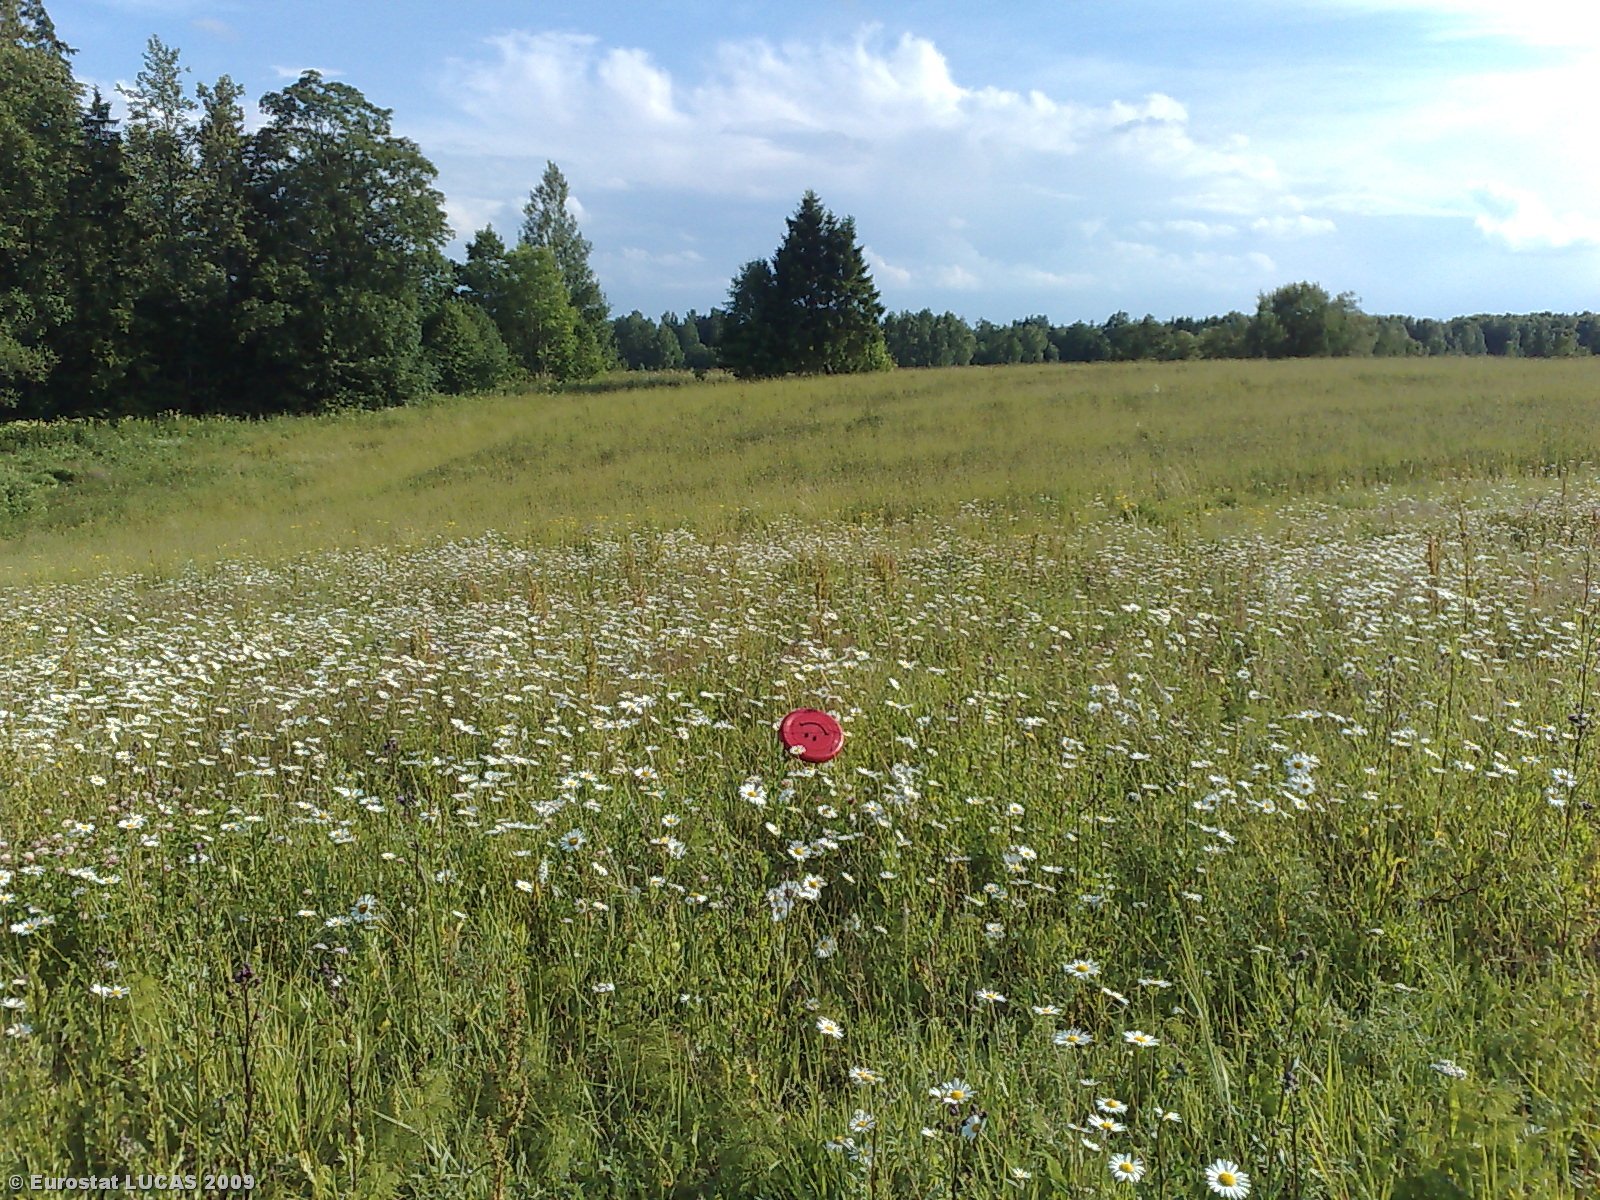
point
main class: Grassland
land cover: Grassland without tree/shrub cover
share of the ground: > 75 %
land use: Agriculture (excluding fallow land and kitchen gardens)
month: July
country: LT
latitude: 55.5328
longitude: 22.7239
